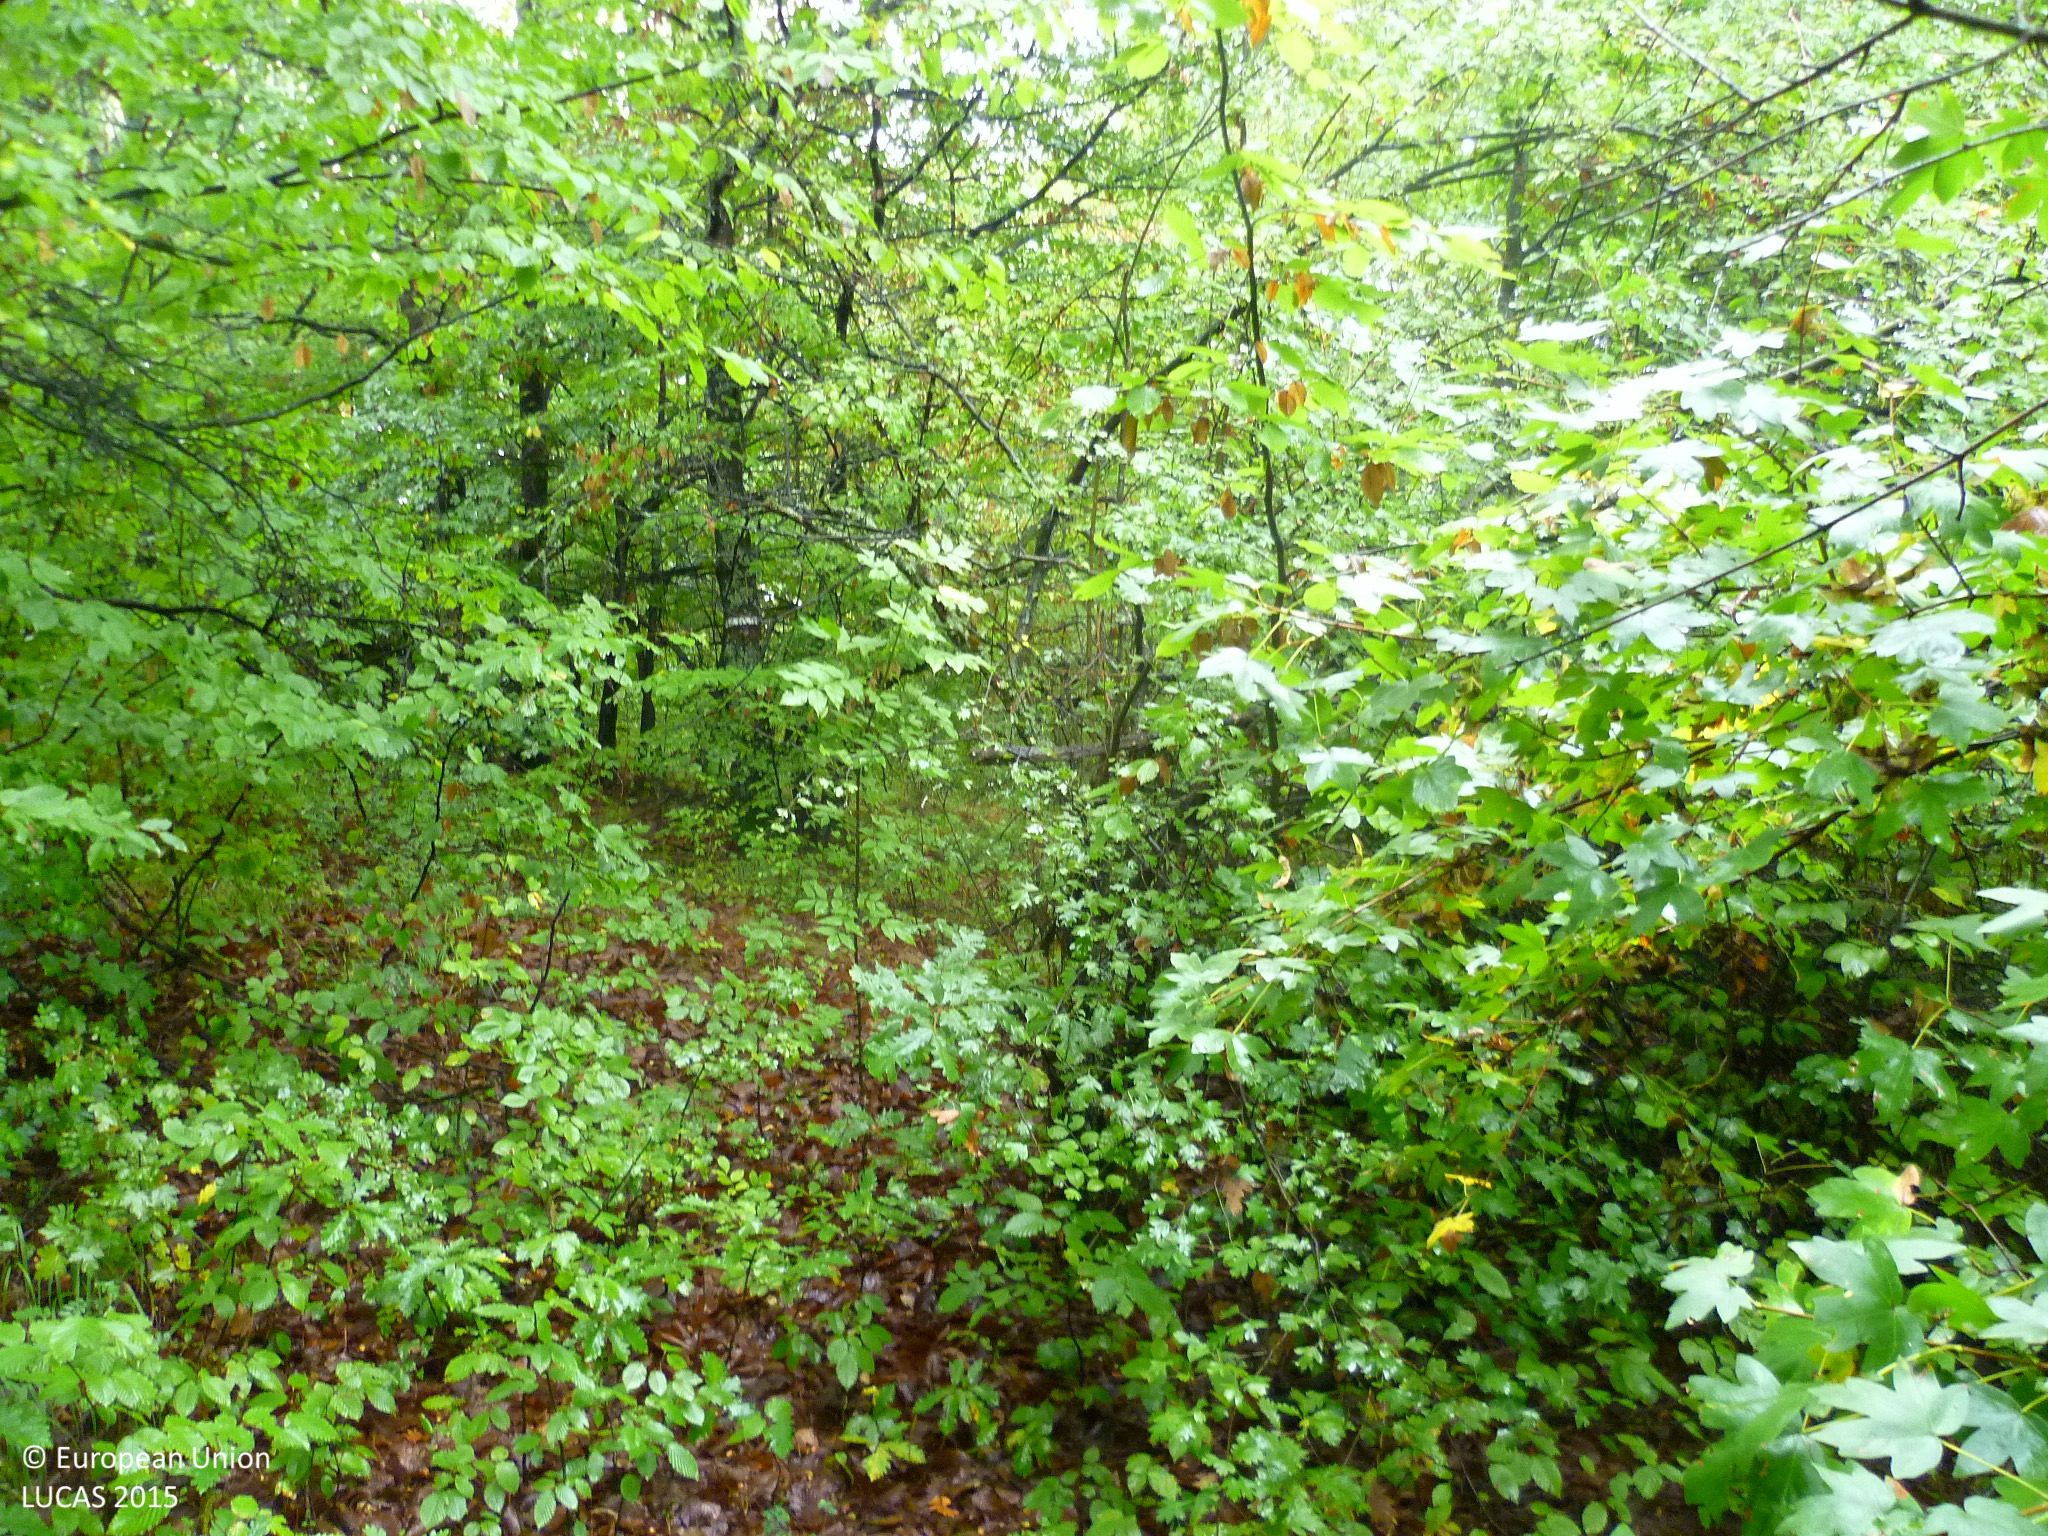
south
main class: Woodland
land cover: Broadleaved woodland
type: mesophytic deciduous forest
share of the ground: > 75 %
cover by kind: broadleaved forest trees 95 %, herbaceous plants 5 %
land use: Forestry
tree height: > 5 m
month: October
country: BG
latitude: 42.6361
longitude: 22.8440
